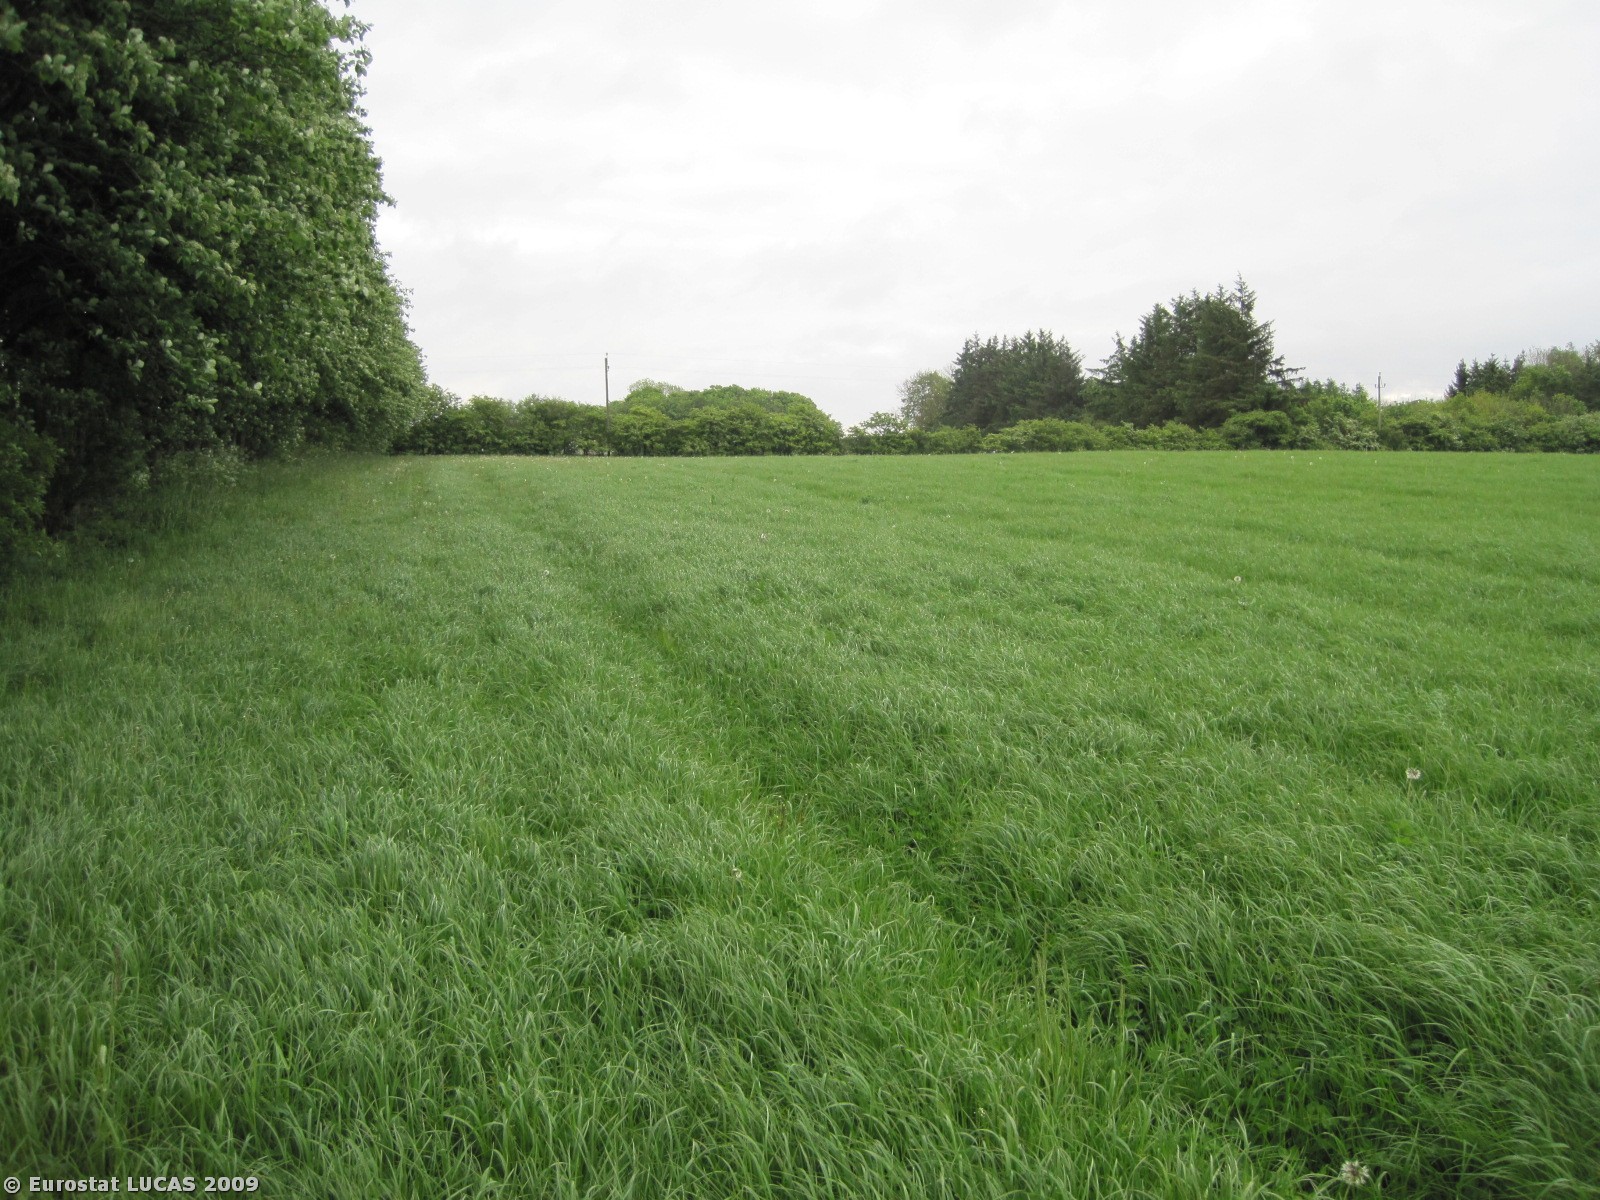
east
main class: Grassland
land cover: Grassland without tree/shrub cover
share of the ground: > 75 %
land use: Agriculture (excluding fallow land and kitchen gardens)
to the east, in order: Grassland without tree/shrub cover; Abandoned hedges; Grassland without tree/shrub cover; Fences; Grassland without tree/shrub cover; Fences; Artificial constructions in urban areas
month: May
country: DK
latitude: 56.8347
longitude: 9.7545
